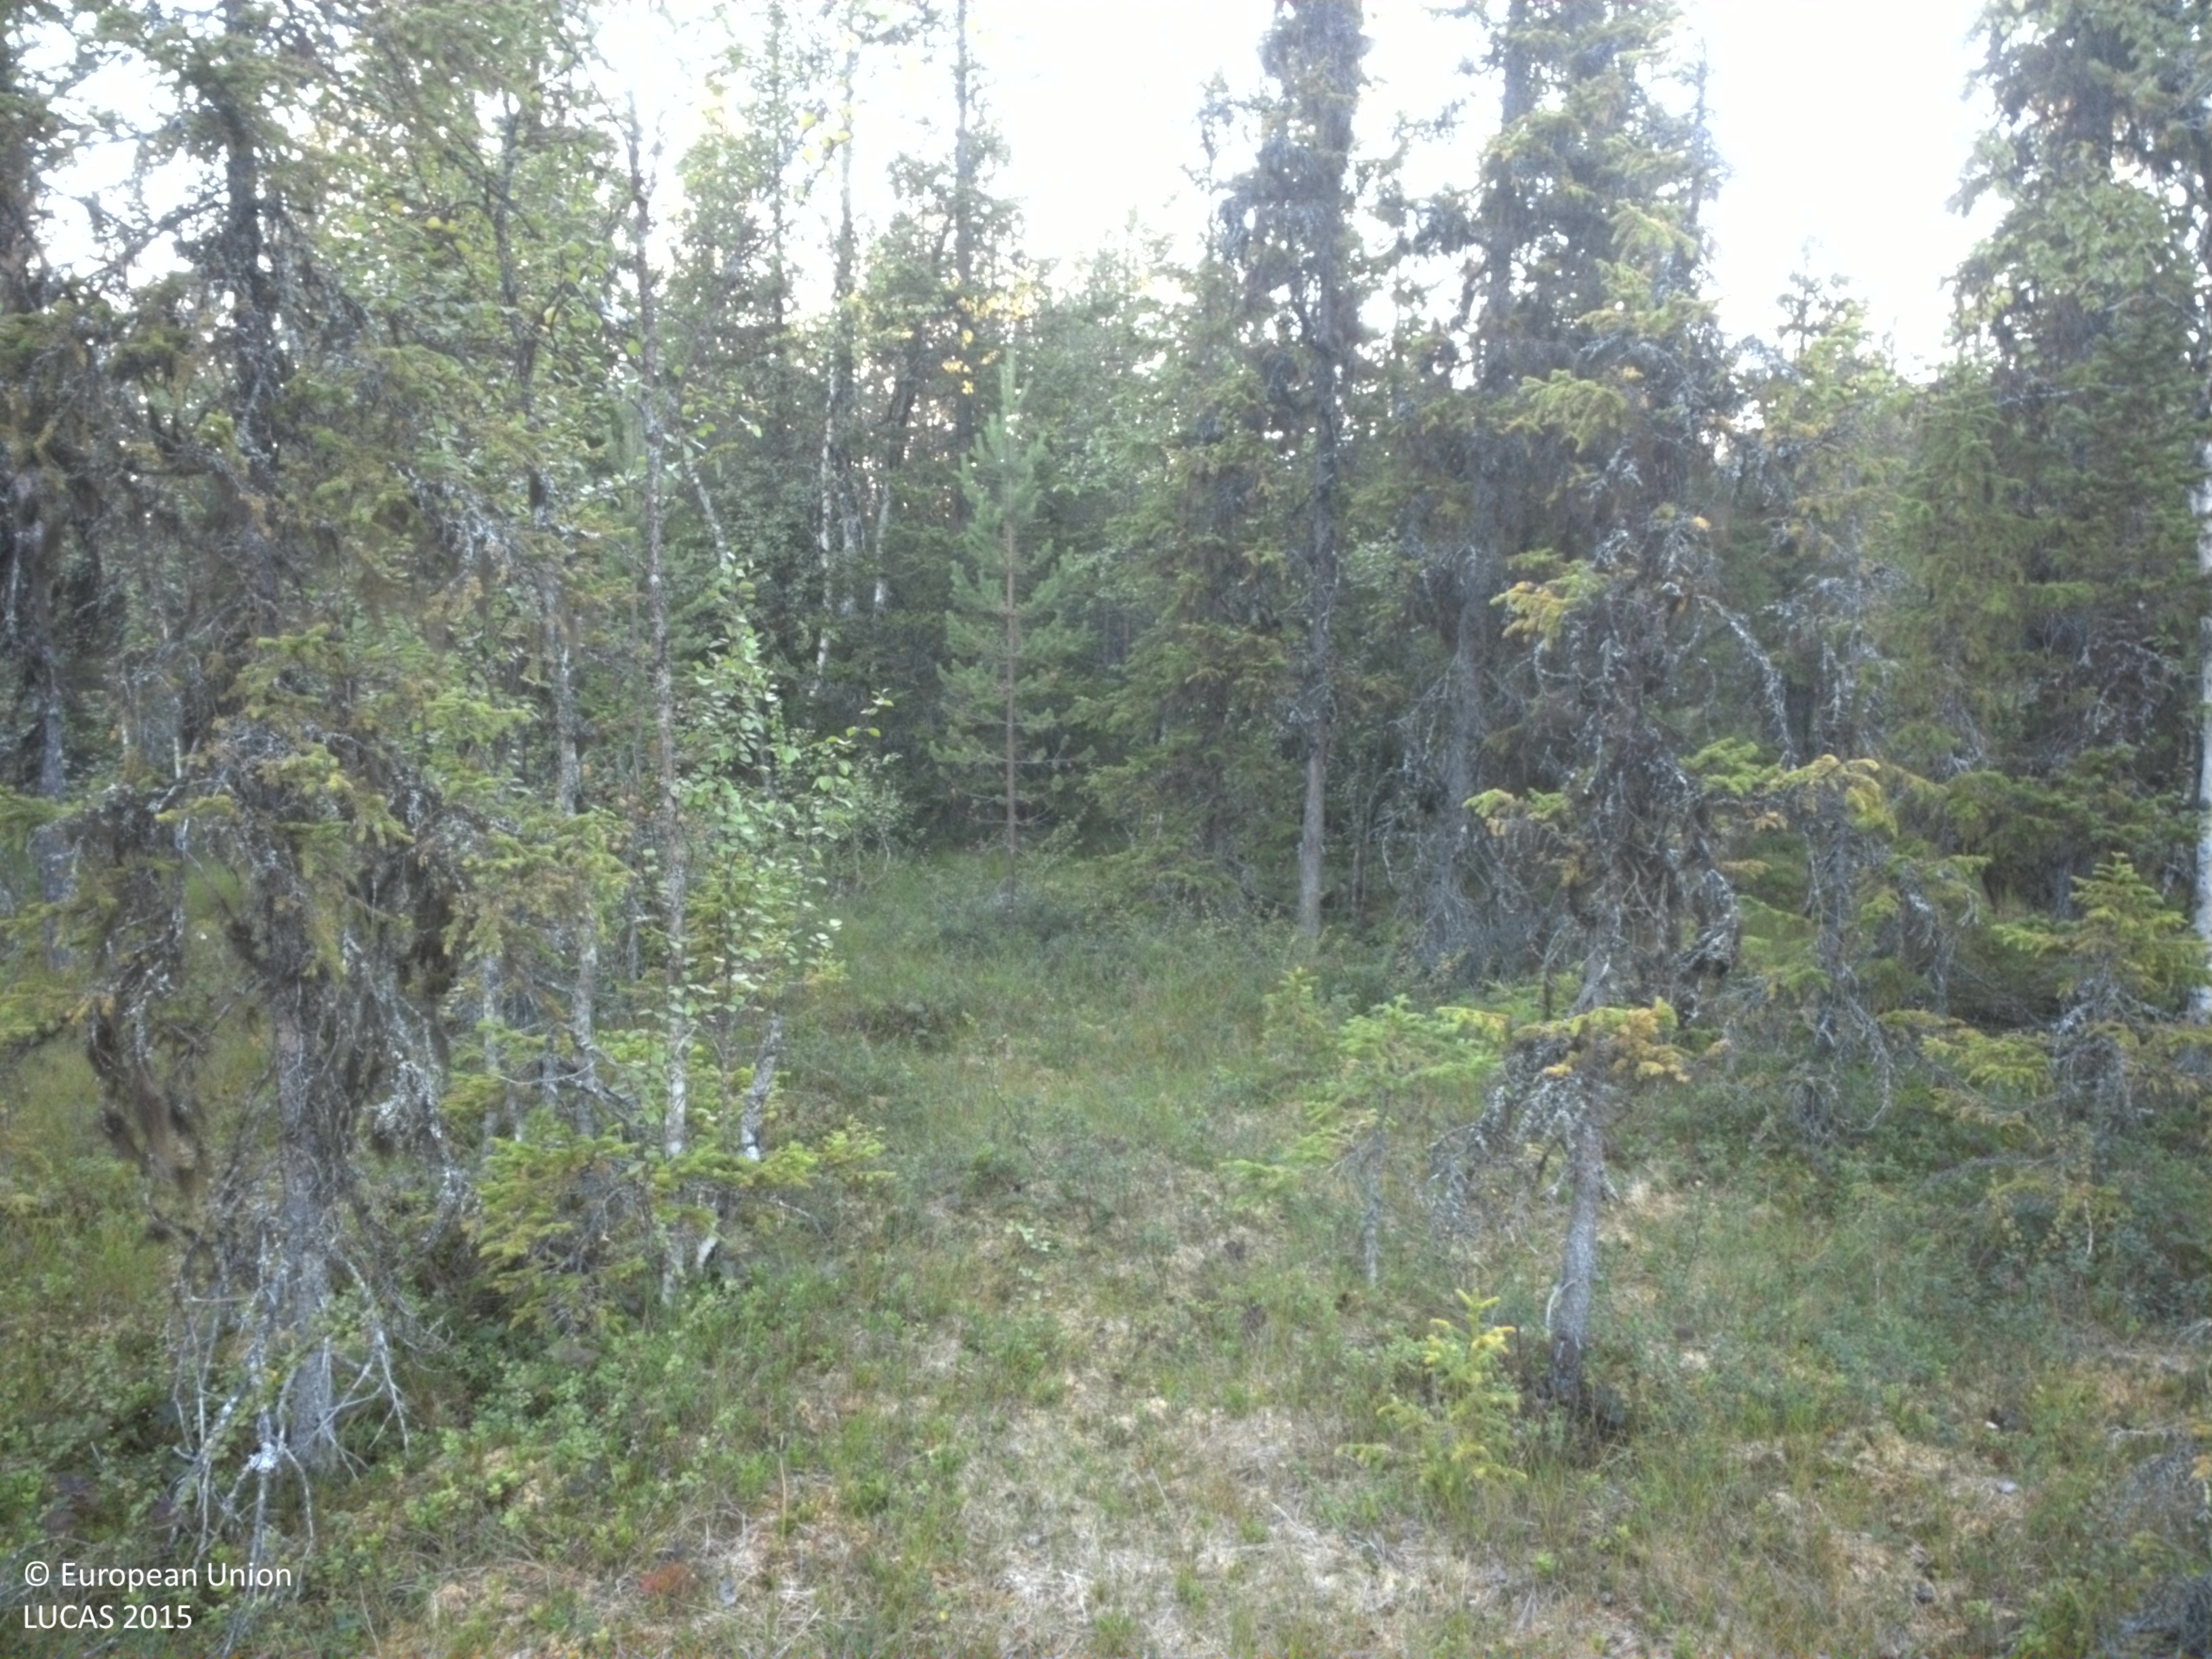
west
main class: Woodland
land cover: Pine dominated coniferous woodland
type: boreal forest
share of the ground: 25 - 50 %
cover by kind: coniferous forest trees 35 %, lichens and mosses 30 %, herbaceous plants 20 %, shrubs 15 %
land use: Forestry
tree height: > 5 m
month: August
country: SE
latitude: 64.4514
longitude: 18.6767
